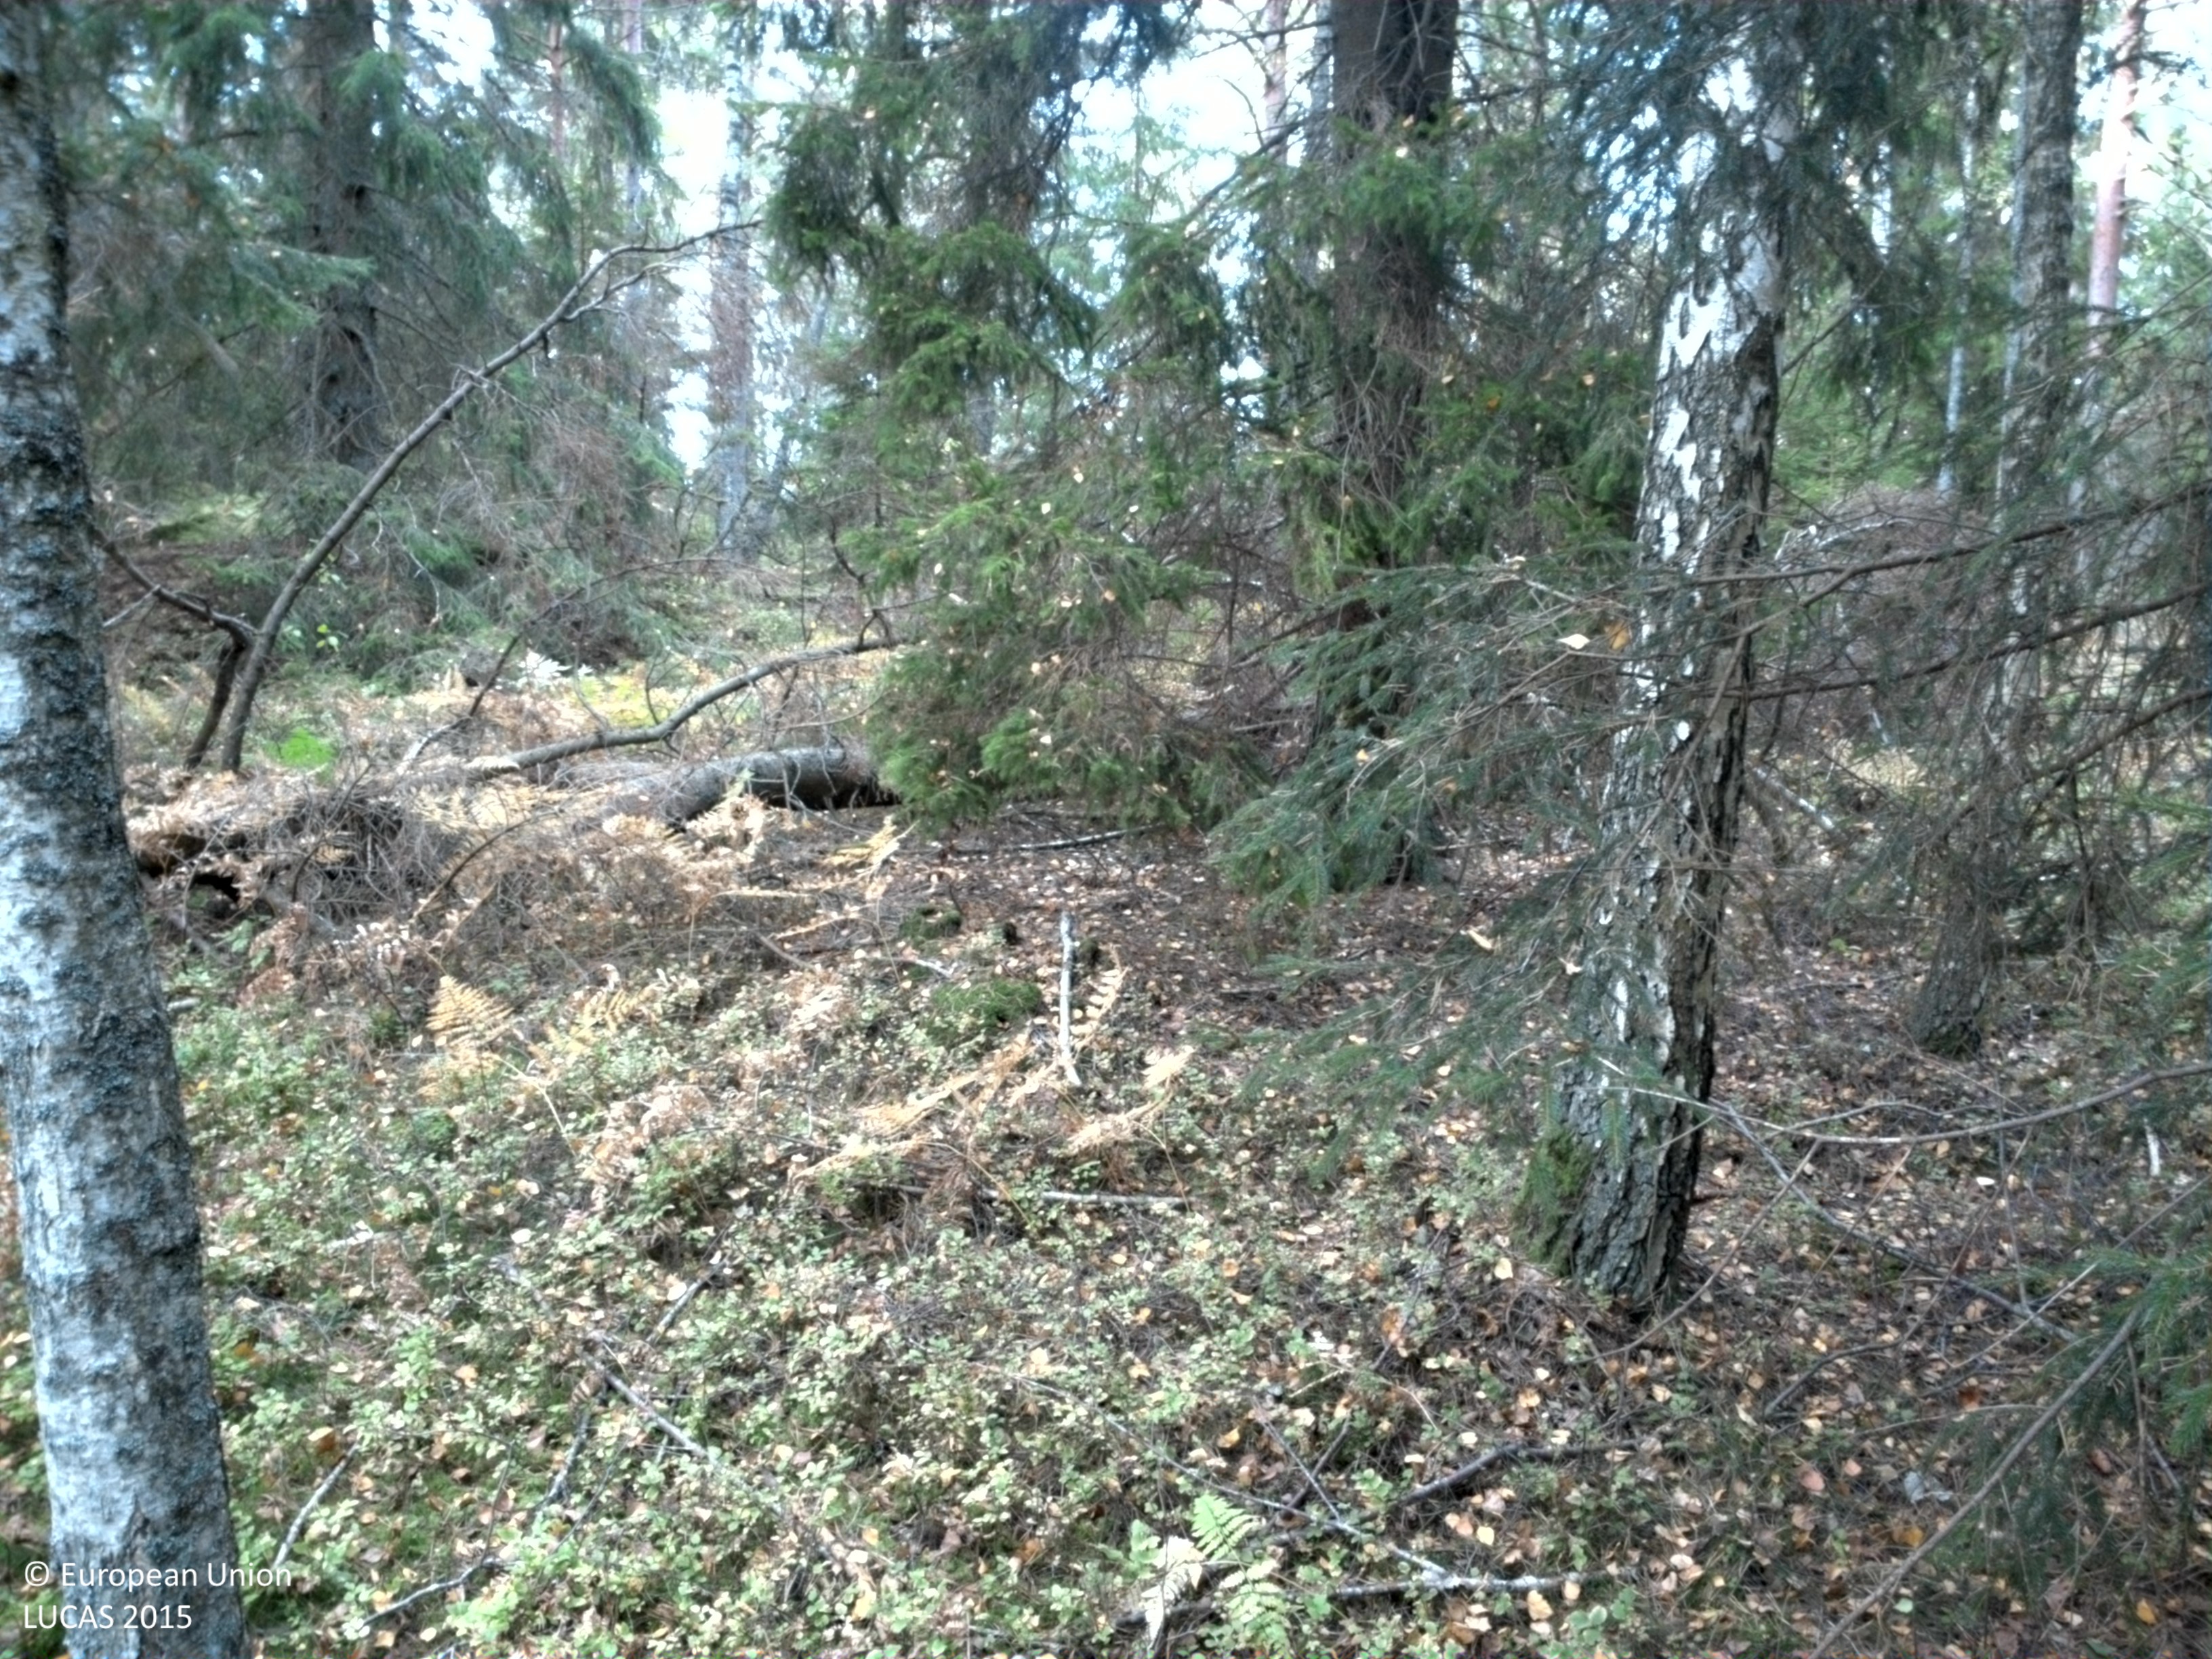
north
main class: Woodland
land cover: Spruce dominated mixed woodland
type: boreal forest
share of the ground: 10 - 25 %
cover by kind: shrubs 50 %, lichens and mosses 20 %, coniferous forest trees 15 %, broadleaved forest trees 10 %, herbaceous plants 5 %
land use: Forestry
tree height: > 5 m
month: October
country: SE
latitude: 58.4749
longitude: 12.9609
